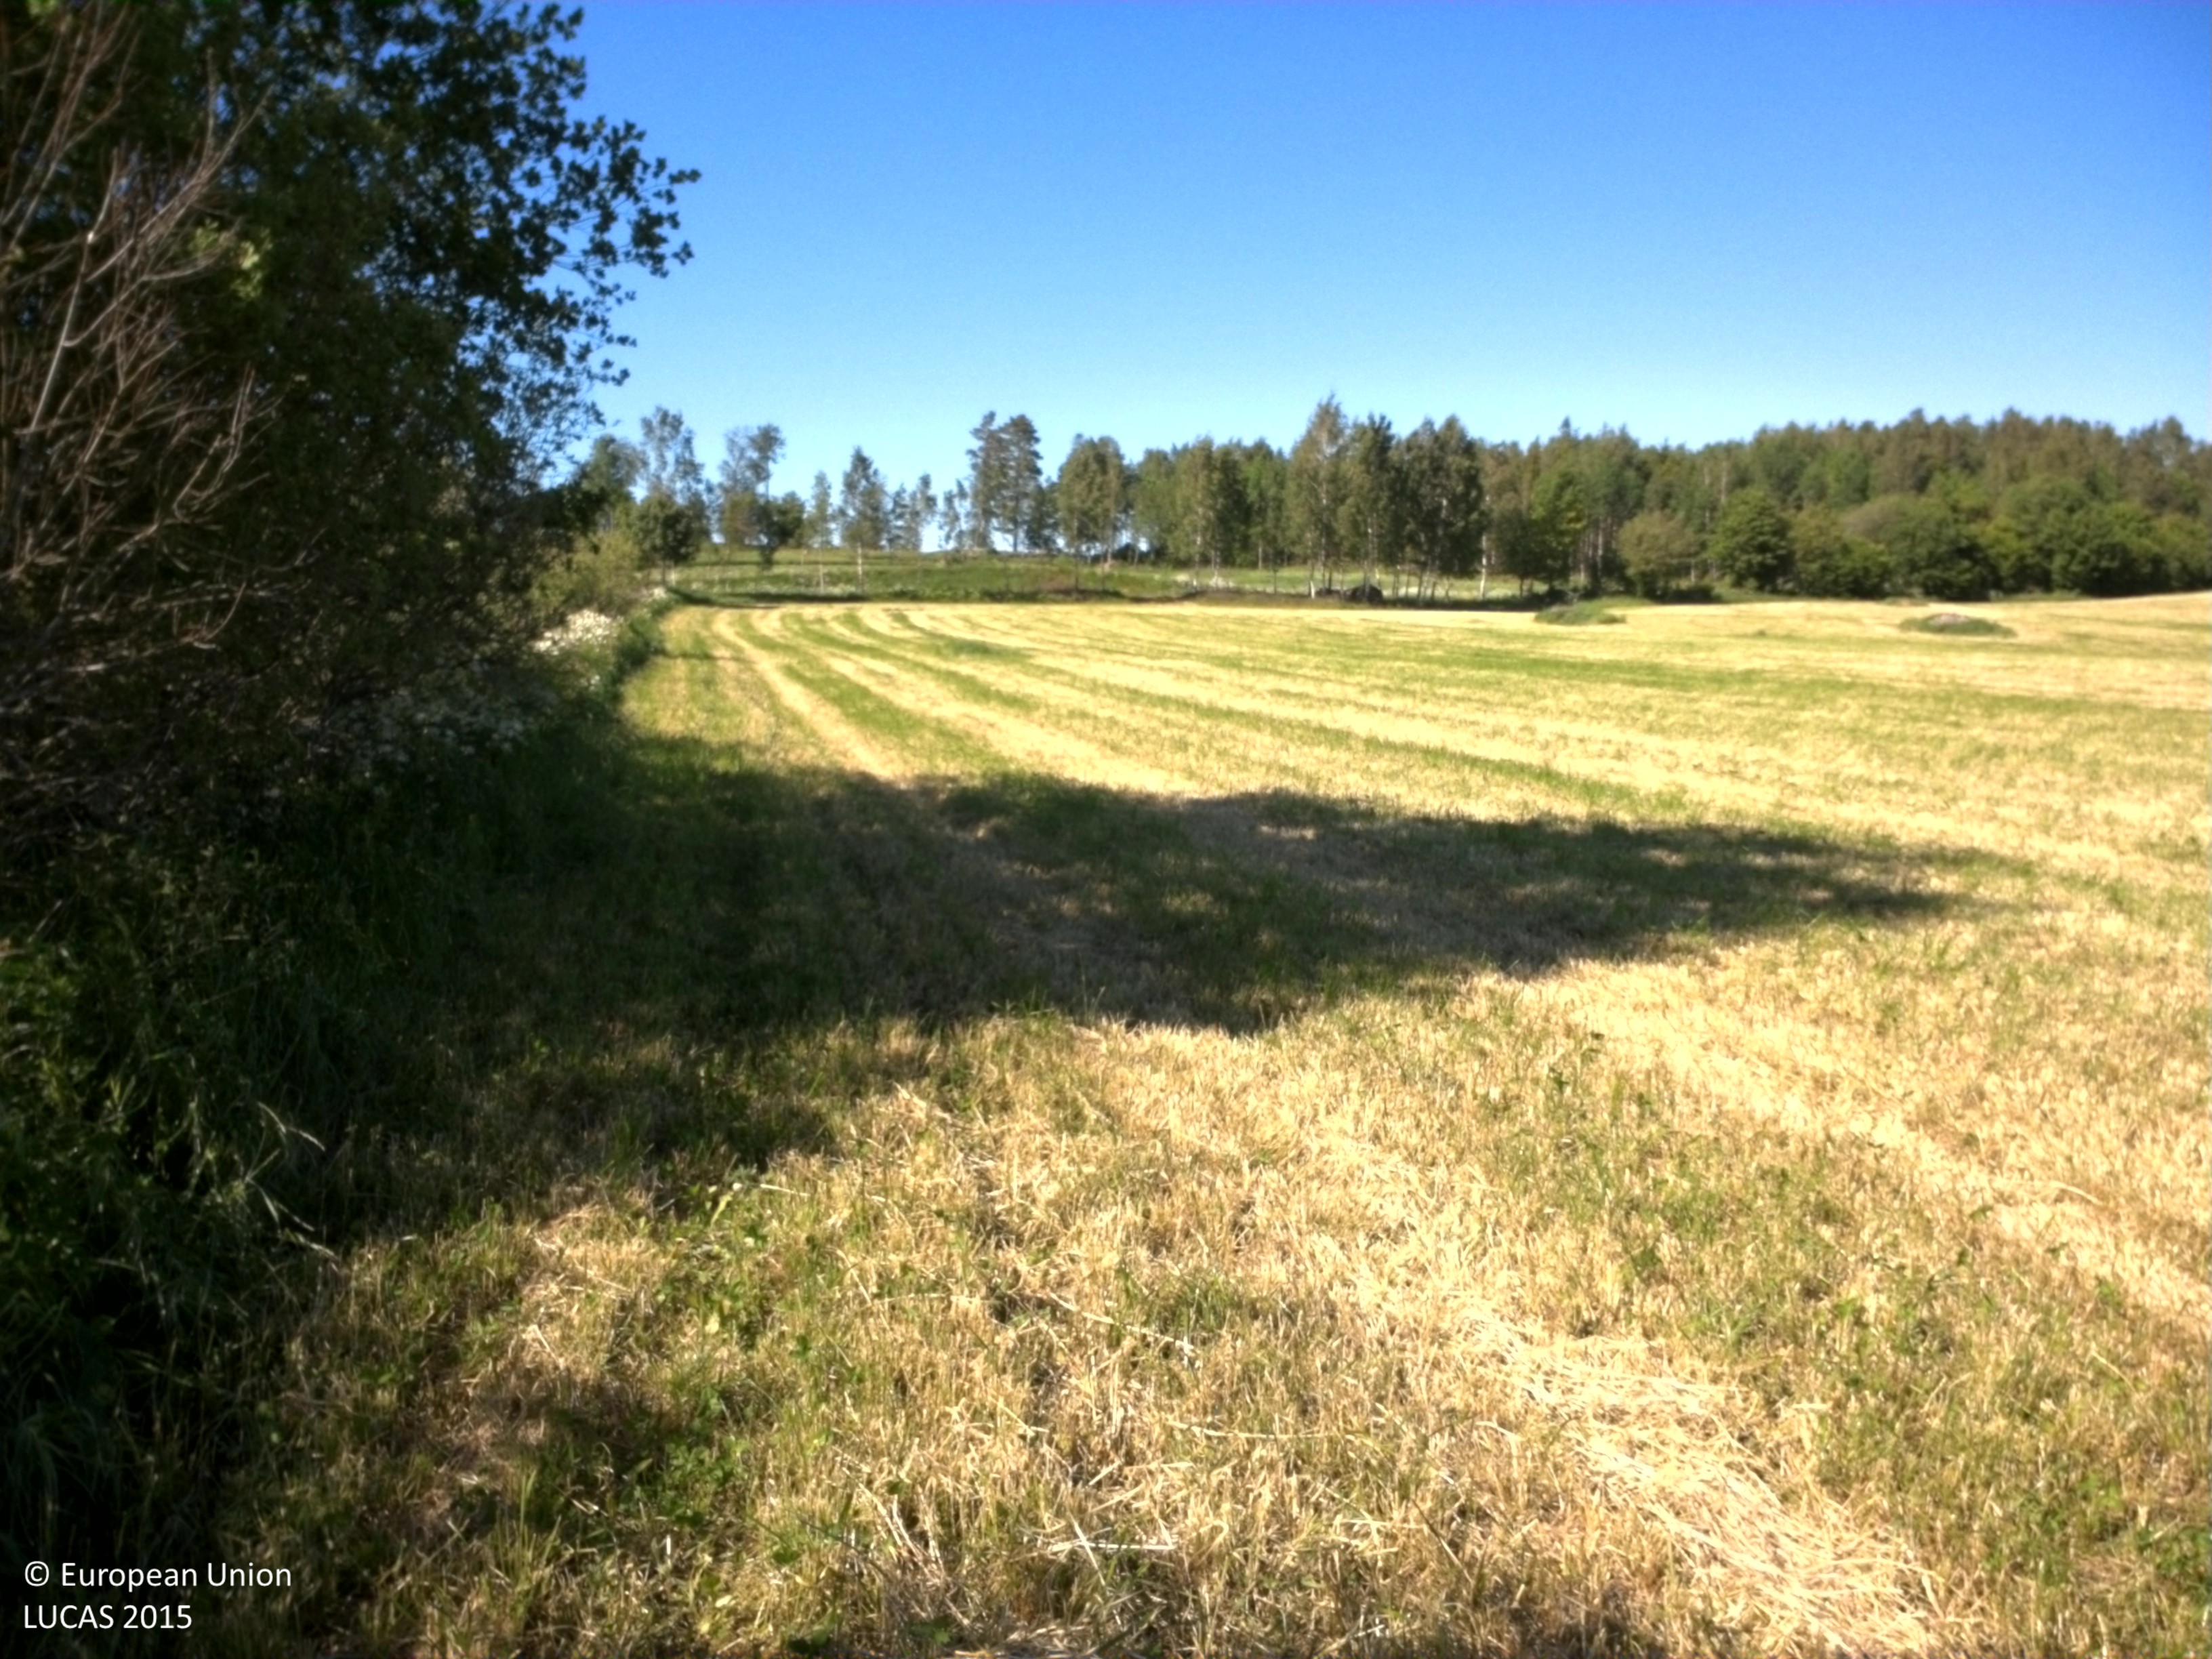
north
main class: Cropland
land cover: Other leguminous and mixtures for fodder
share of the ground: > 75 %
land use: Agriculture (excluding fallow land and kitchen gardens)
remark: Harvested field
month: June
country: SE
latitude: 58.4297
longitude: 14.0181
